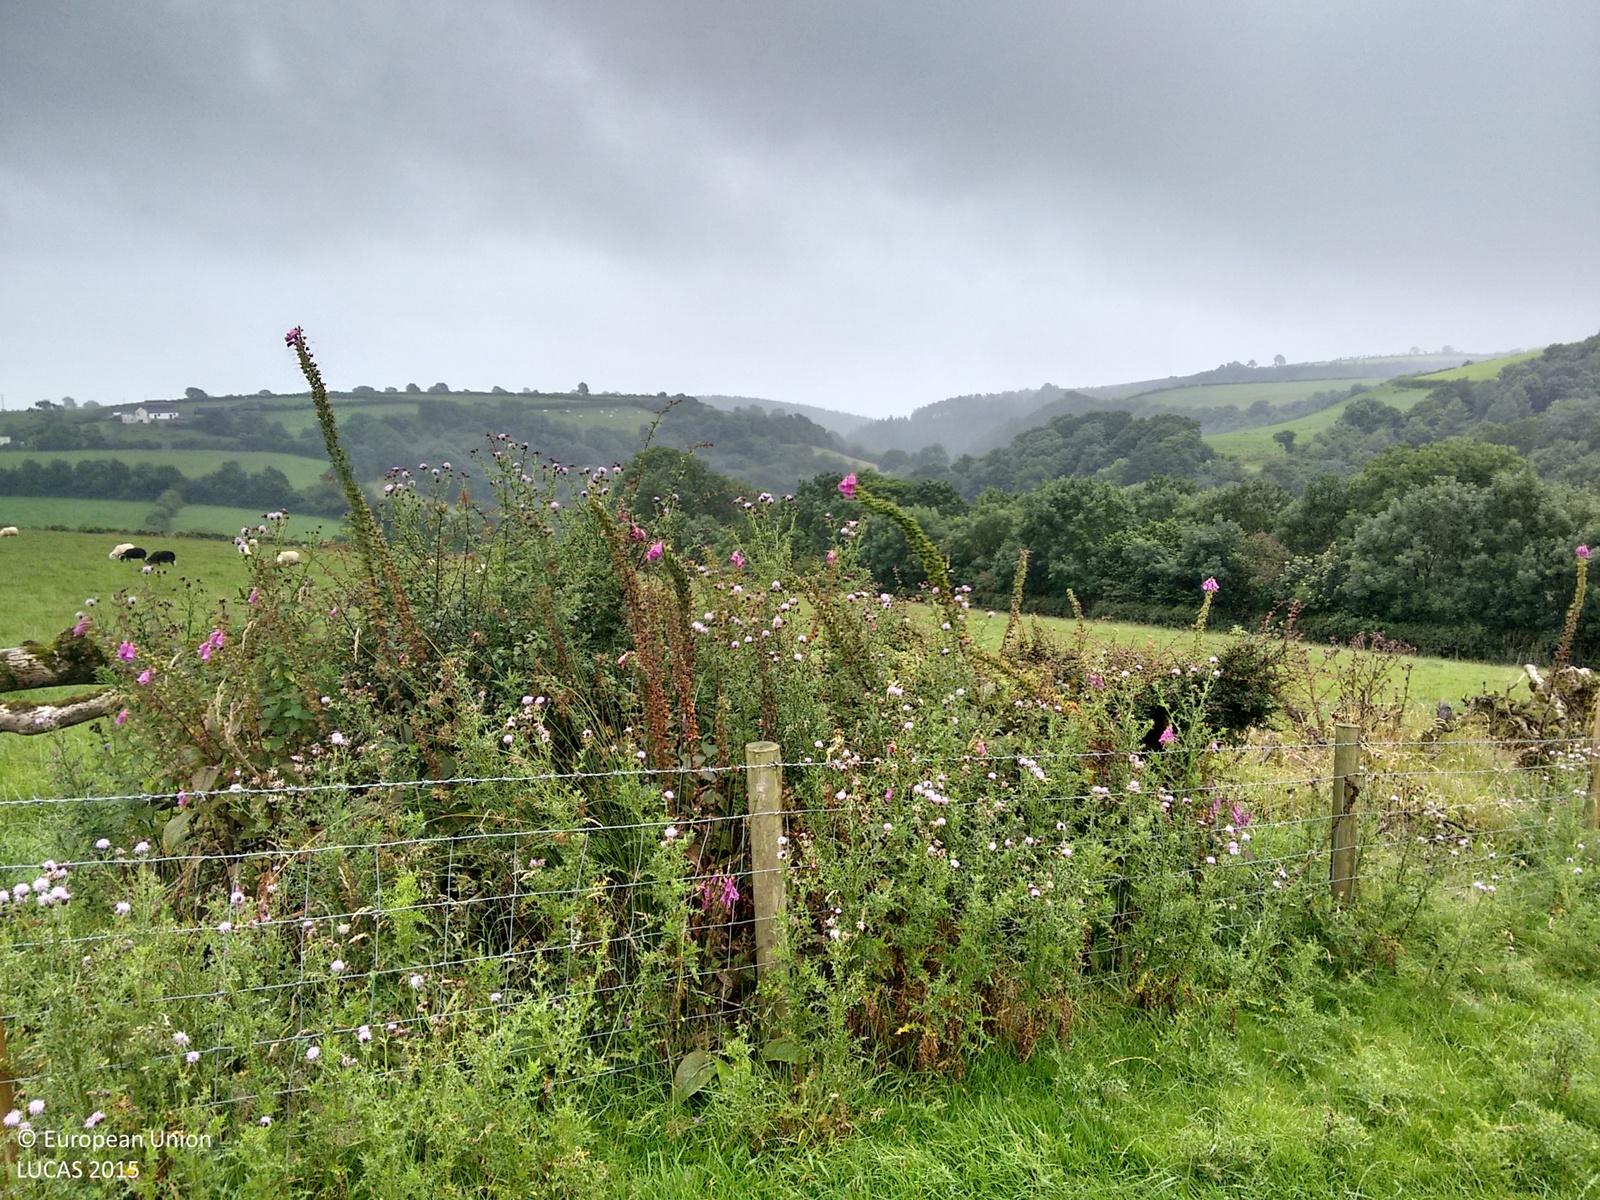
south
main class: Grassland
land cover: Grassland without tree/shrub cover
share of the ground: > 75 %
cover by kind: herbaceous plants 100 %
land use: Agriculture (excluding fallow land and kitchen gardens)
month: August
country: GB
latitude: 51.9072
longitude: -4.4511
